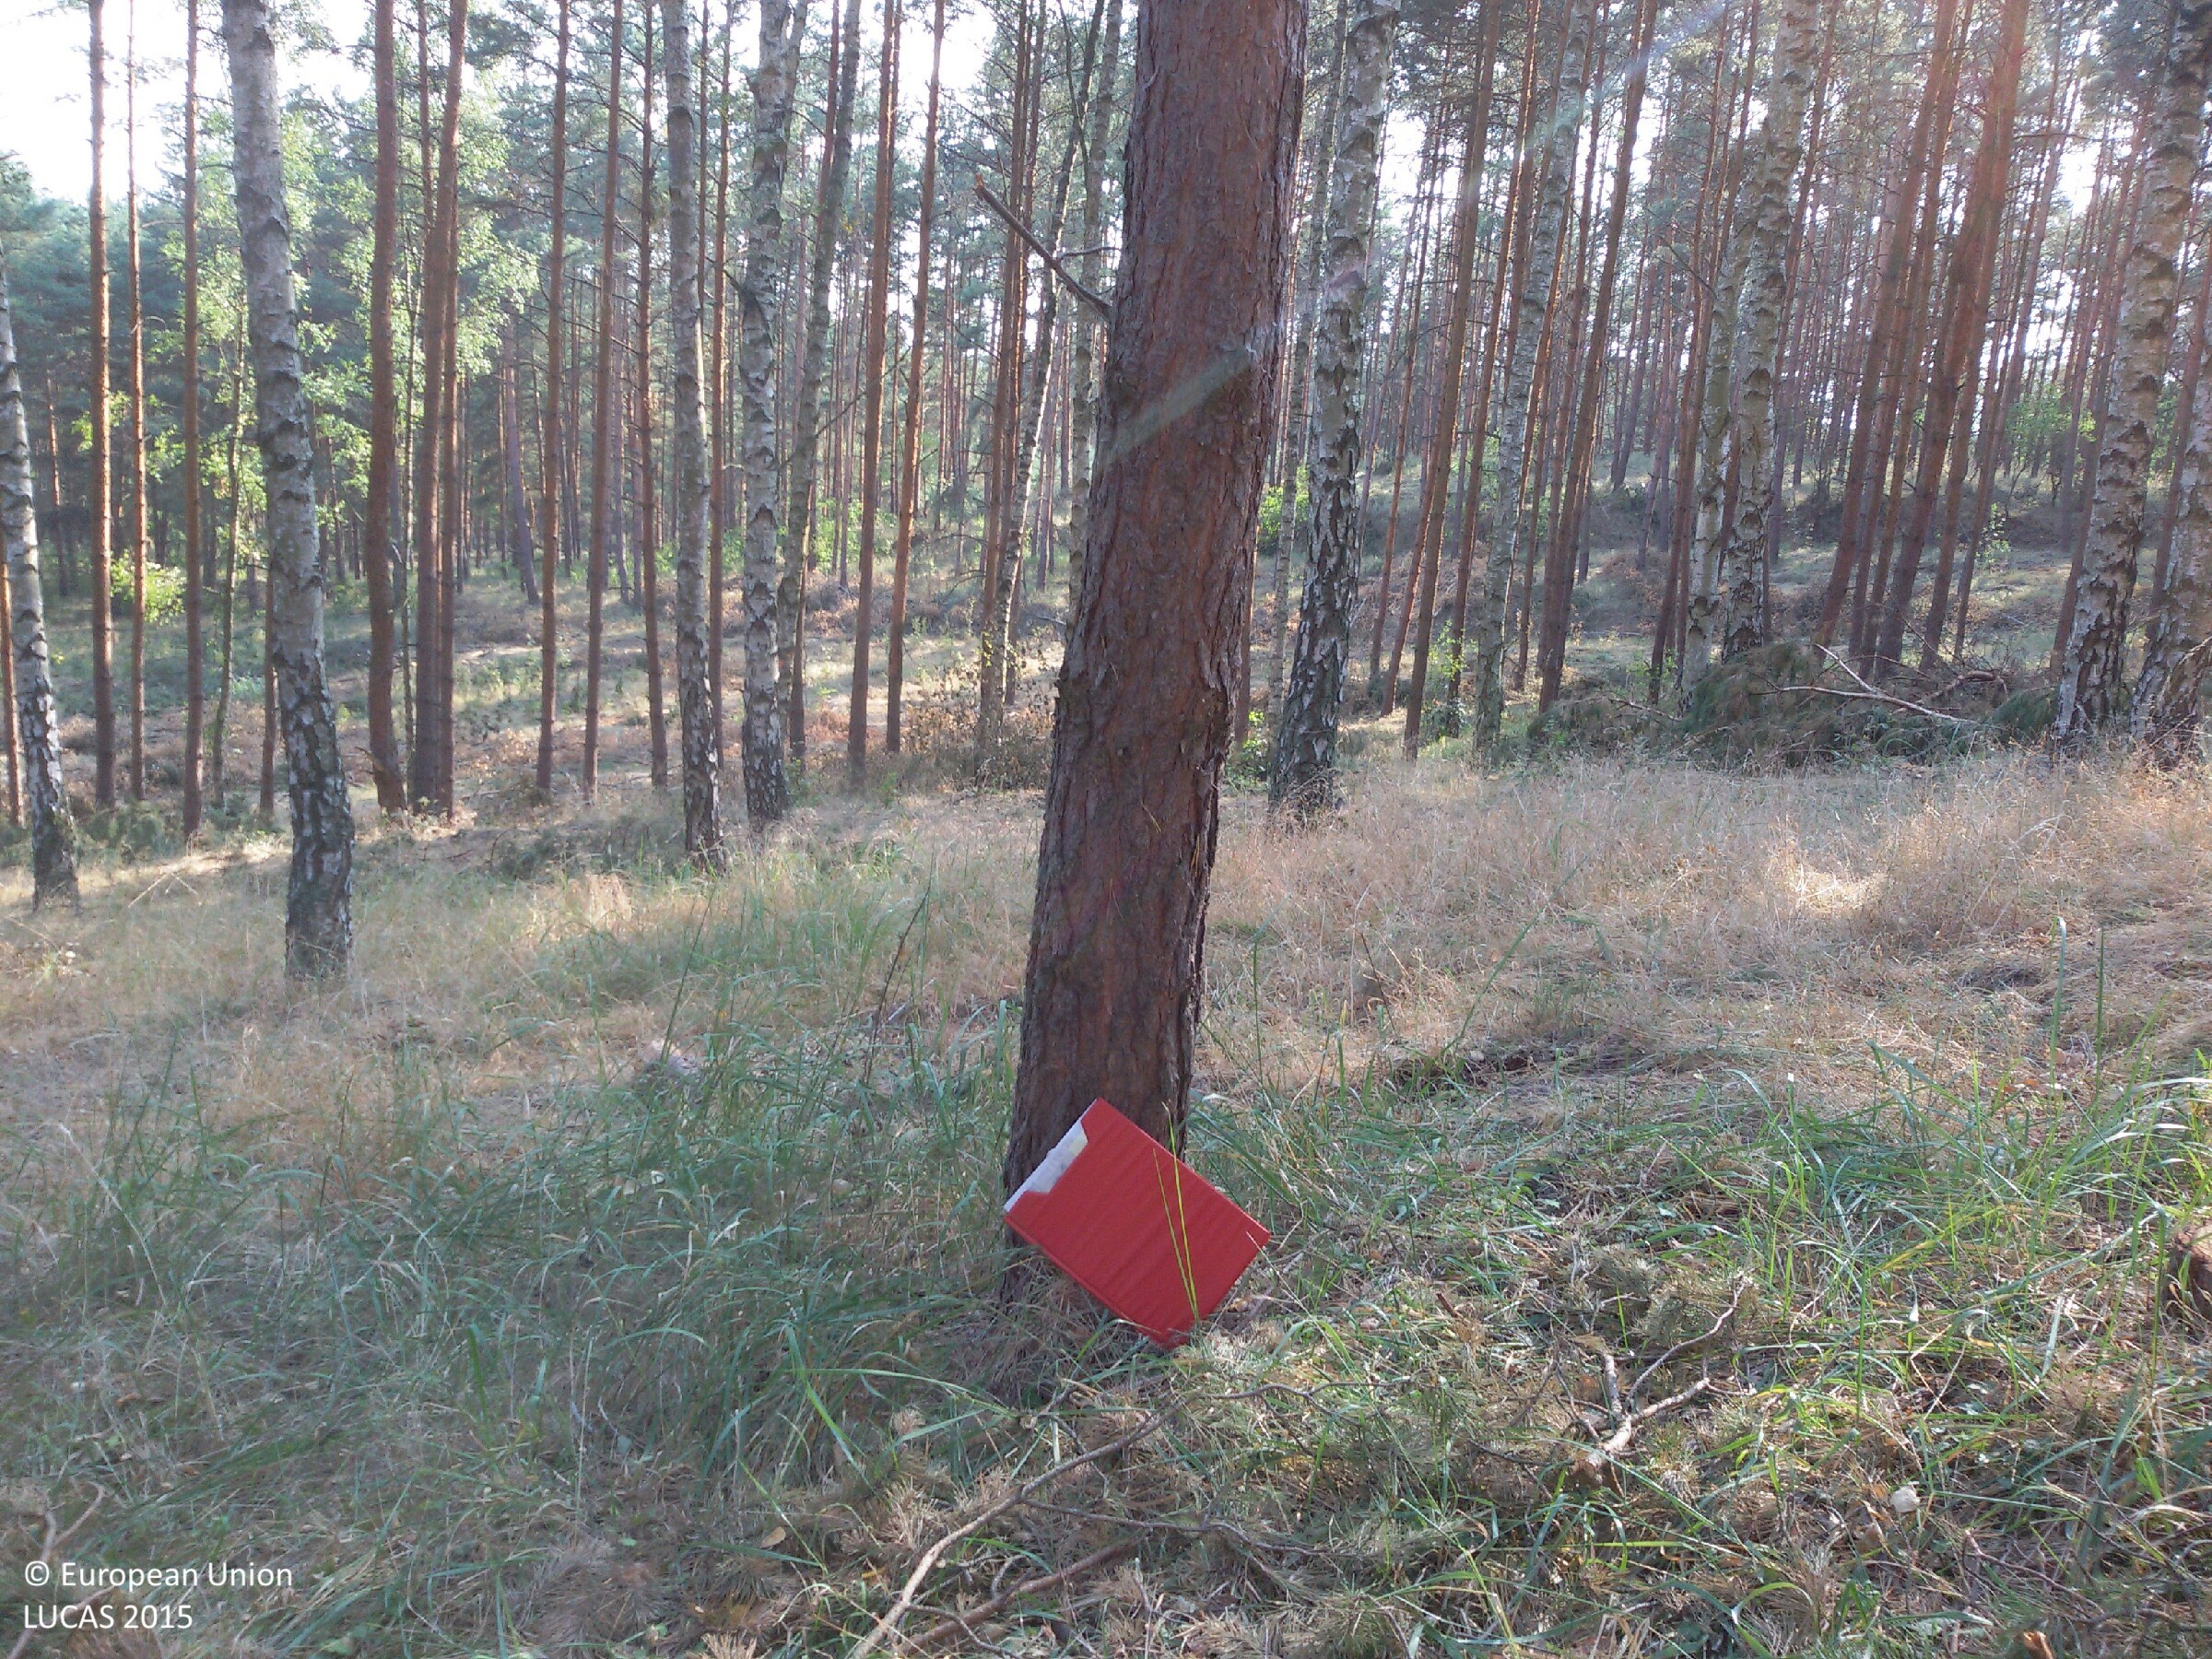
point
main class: Woodland
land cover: Pine dominated mixed woodland
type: hemiboreal forest and nemoral coniferous forest and mixed broadleaved-coniferous forest
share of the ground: > 75 %
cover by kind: coniferous forest trees 55 %, broadleaved forest trees 20 %, herbaceous plants 20 %, lichens and mosses 5 %
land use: Forestry
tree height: > 5 m
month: August
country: PL
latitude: 52.8051
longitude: 14.2583
